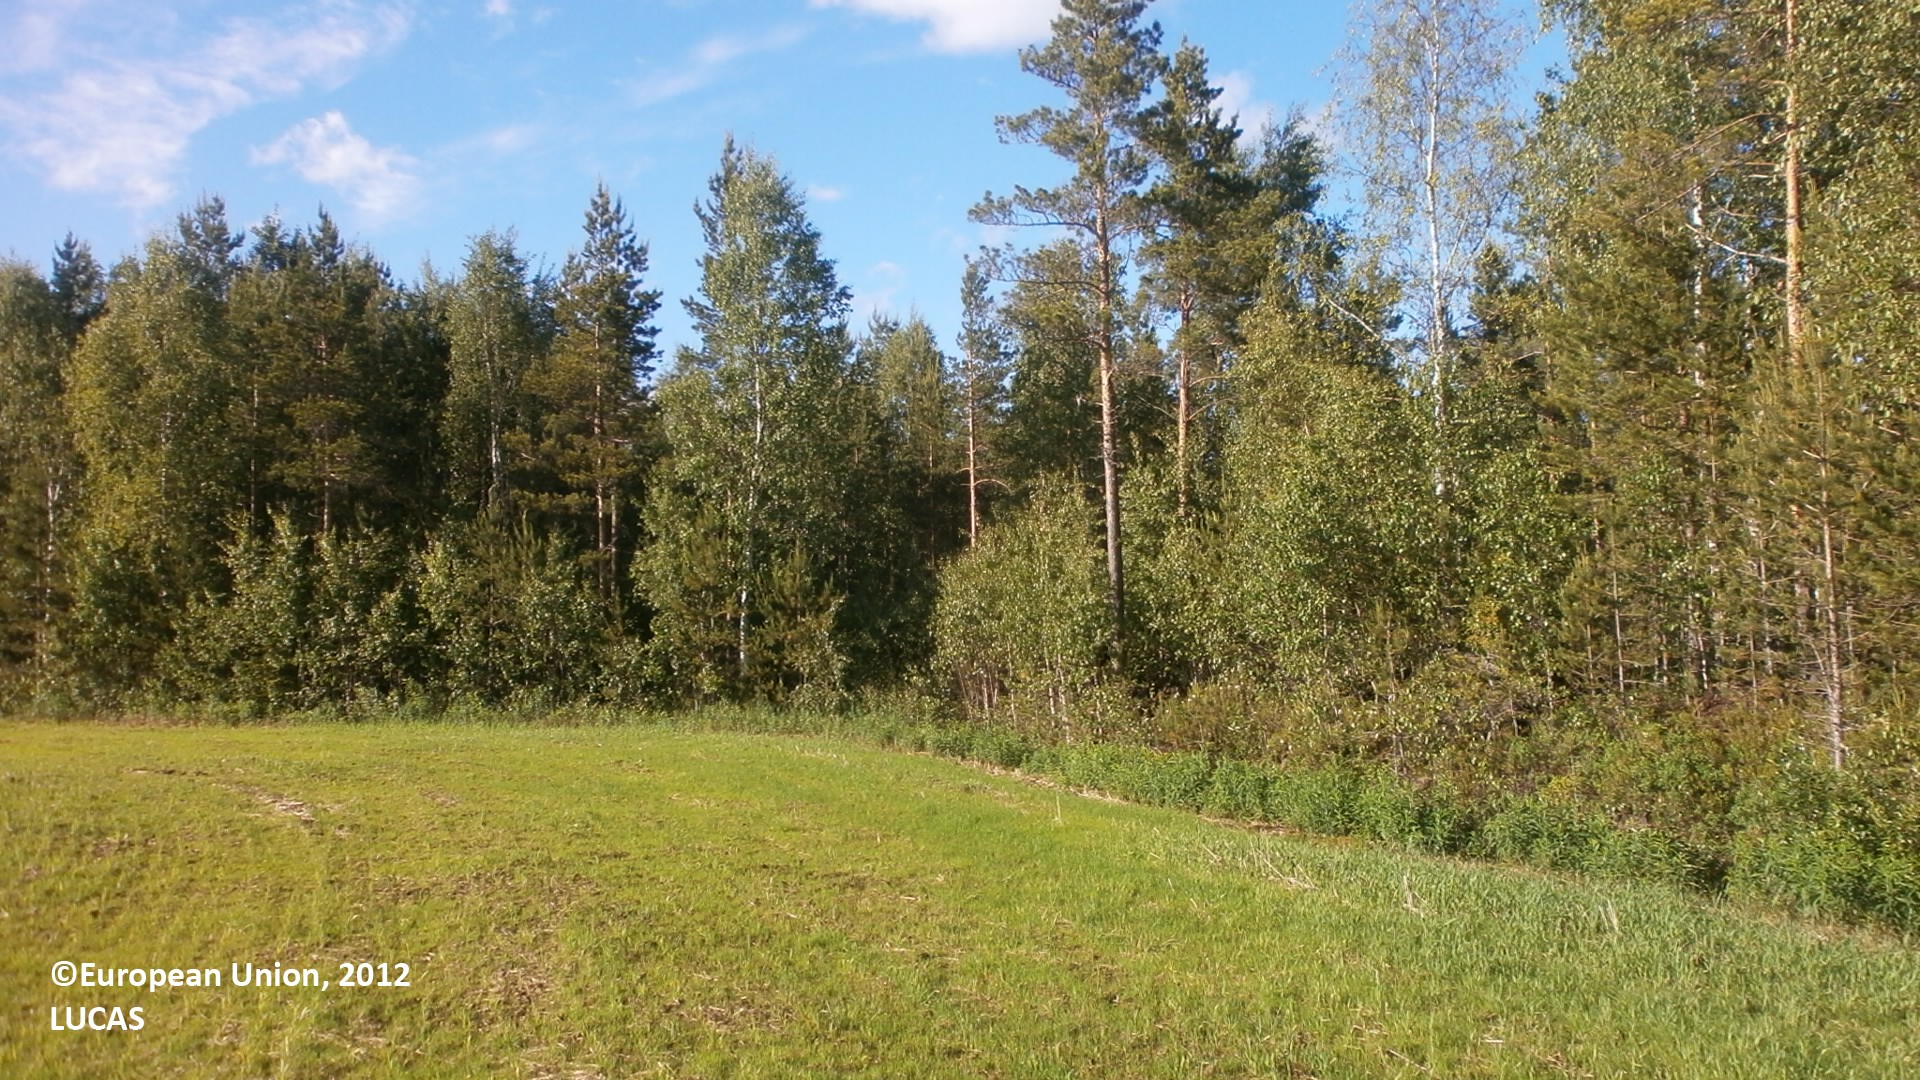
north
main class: Cropland
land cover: Temporary grasslands
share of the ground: 25 - 50 %
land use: Agriculture (excluding fallow land and kitchen gardens)
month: June
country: FI
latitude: 64.4350
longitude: 25.0132
